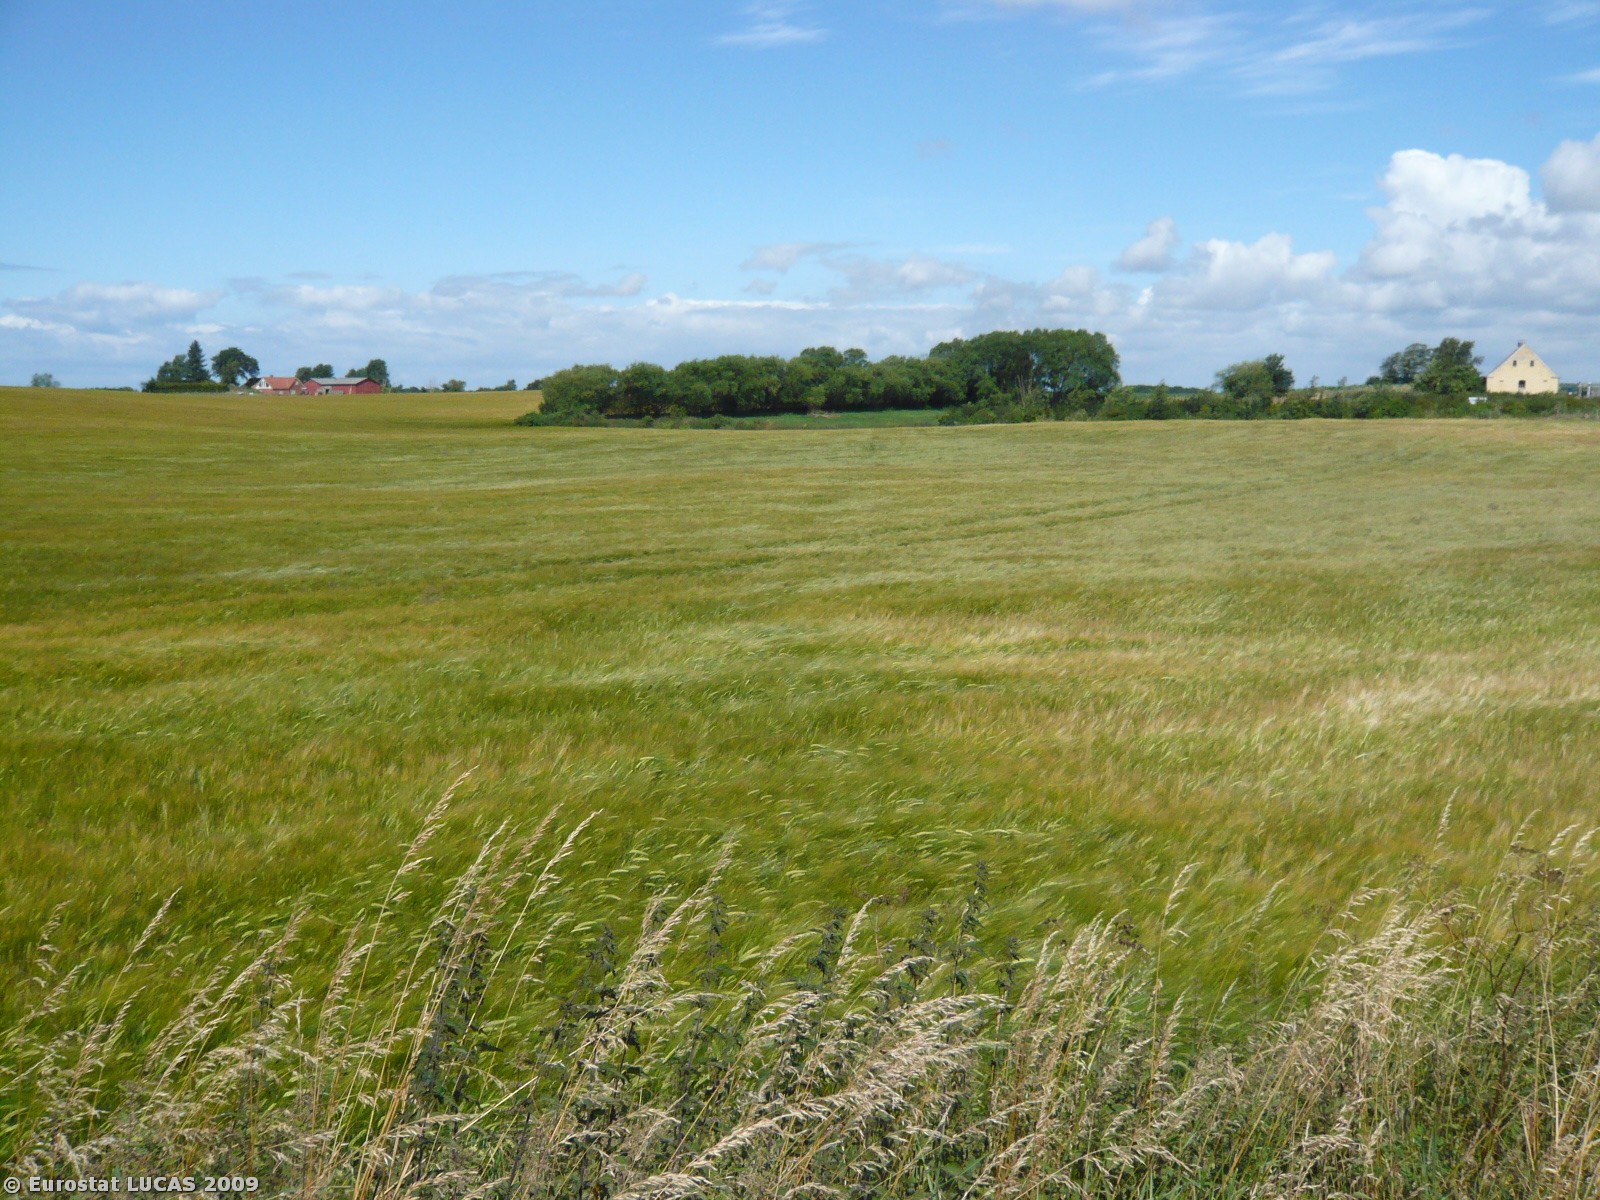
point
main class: Cropland
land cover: Barley
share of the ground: > 75 %
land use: Agriculture (excluding fallow land and kitchen gardens)
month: July
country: DK
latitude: 55.4796
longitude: 11.3437
